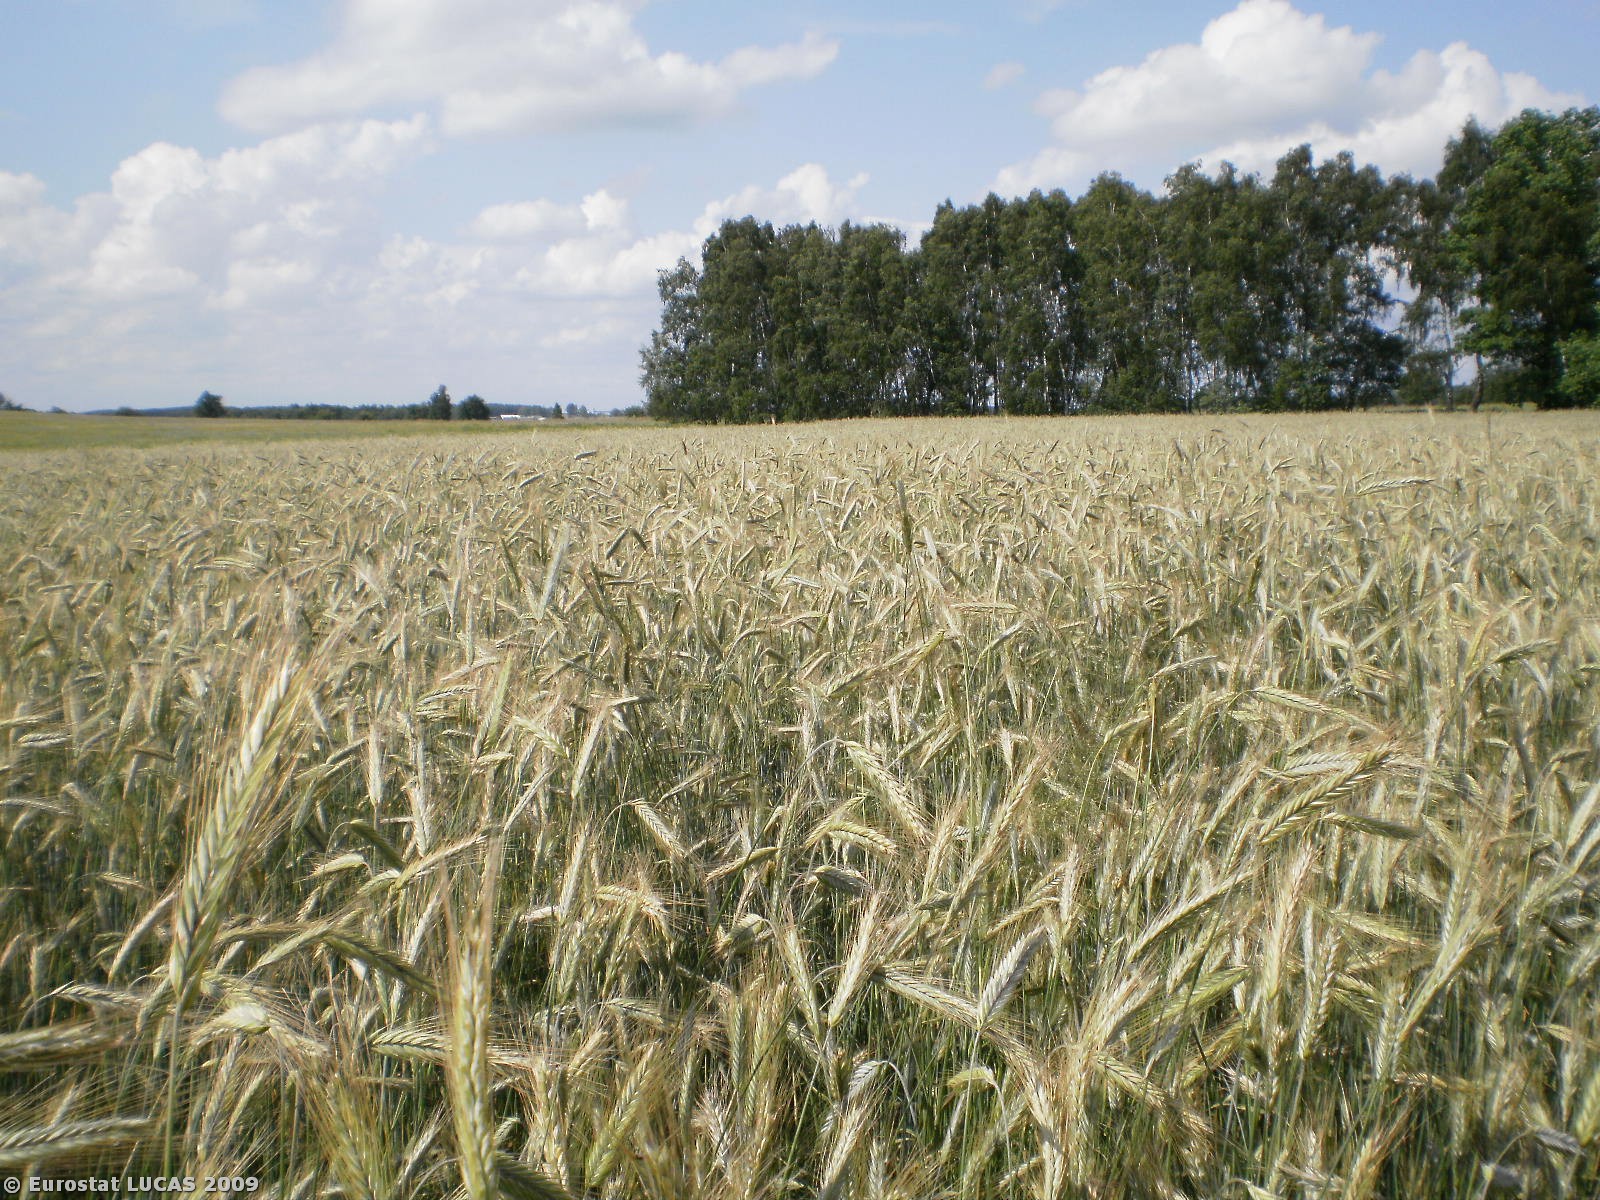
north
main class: Cropland
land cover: Triticale
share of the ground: > 75 %
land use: Agriculture (excluding fallow land and kitchen gardens)
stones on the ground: 10 - 25 %
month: July
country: PL
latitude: 53.2945
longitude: 20.4337
